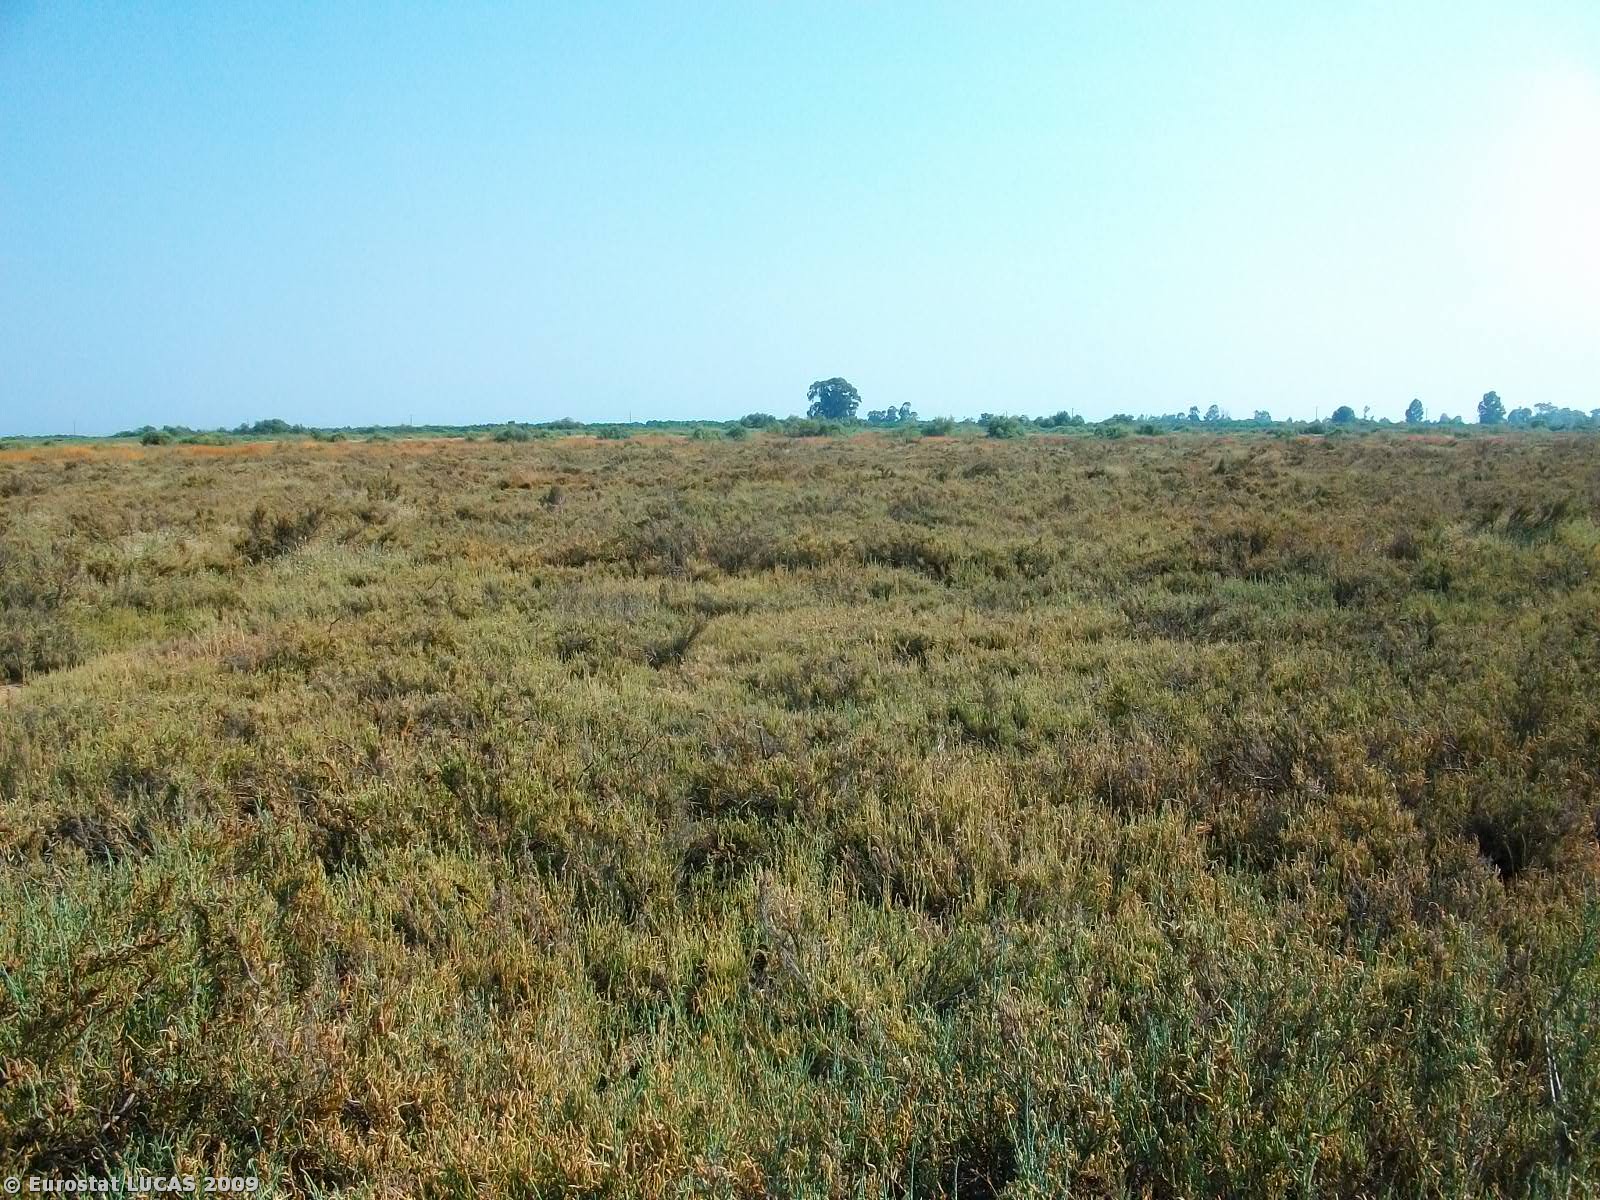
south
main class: Grassland
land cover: Spontaneously vegetated surfaces
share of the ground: > 75 %
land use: Nature reserves
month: August
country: GR
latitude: 36.8159
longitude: 22.7223
